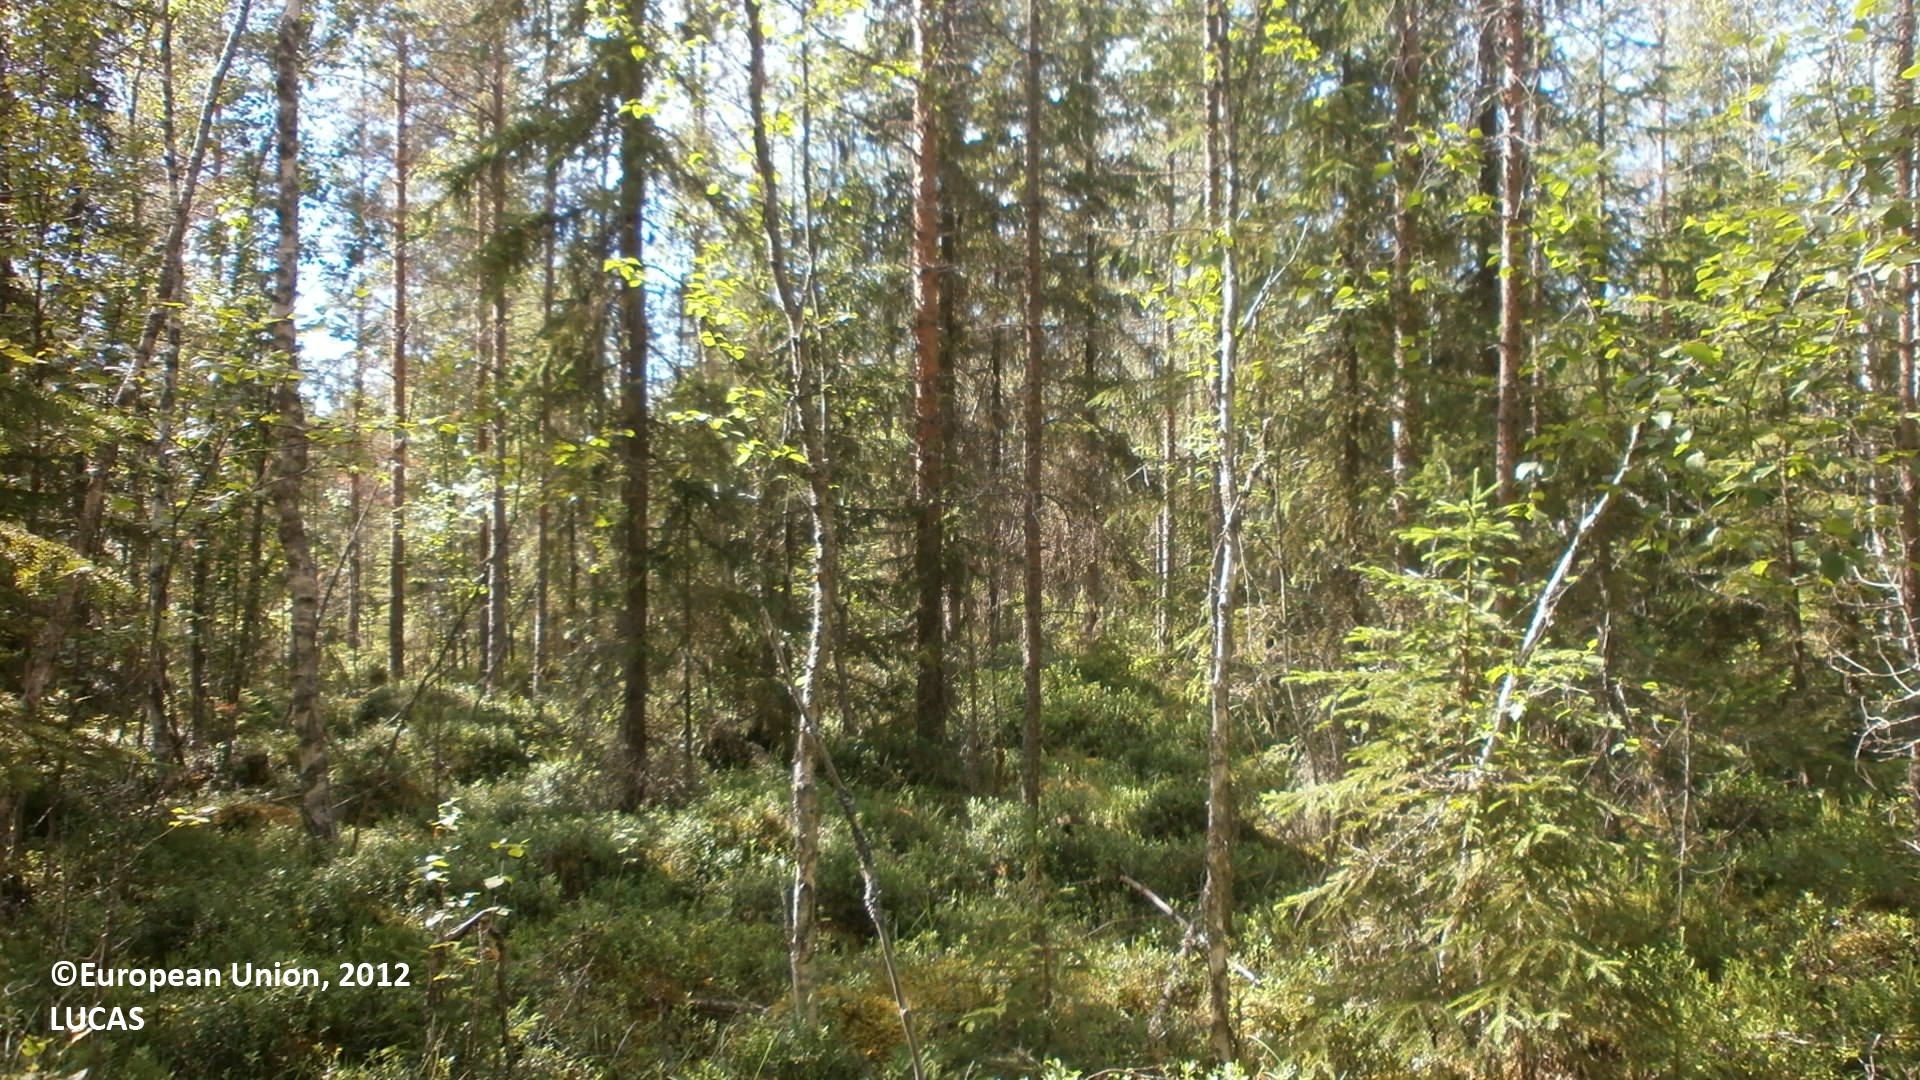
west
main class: Woodland
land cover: Pine dominated coniferous woodland
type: boreal forest
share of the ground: 50 - 75 %
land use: Forestry
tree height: > 5 m
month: July
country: FI
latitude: 63.9851
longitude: 23.8983
